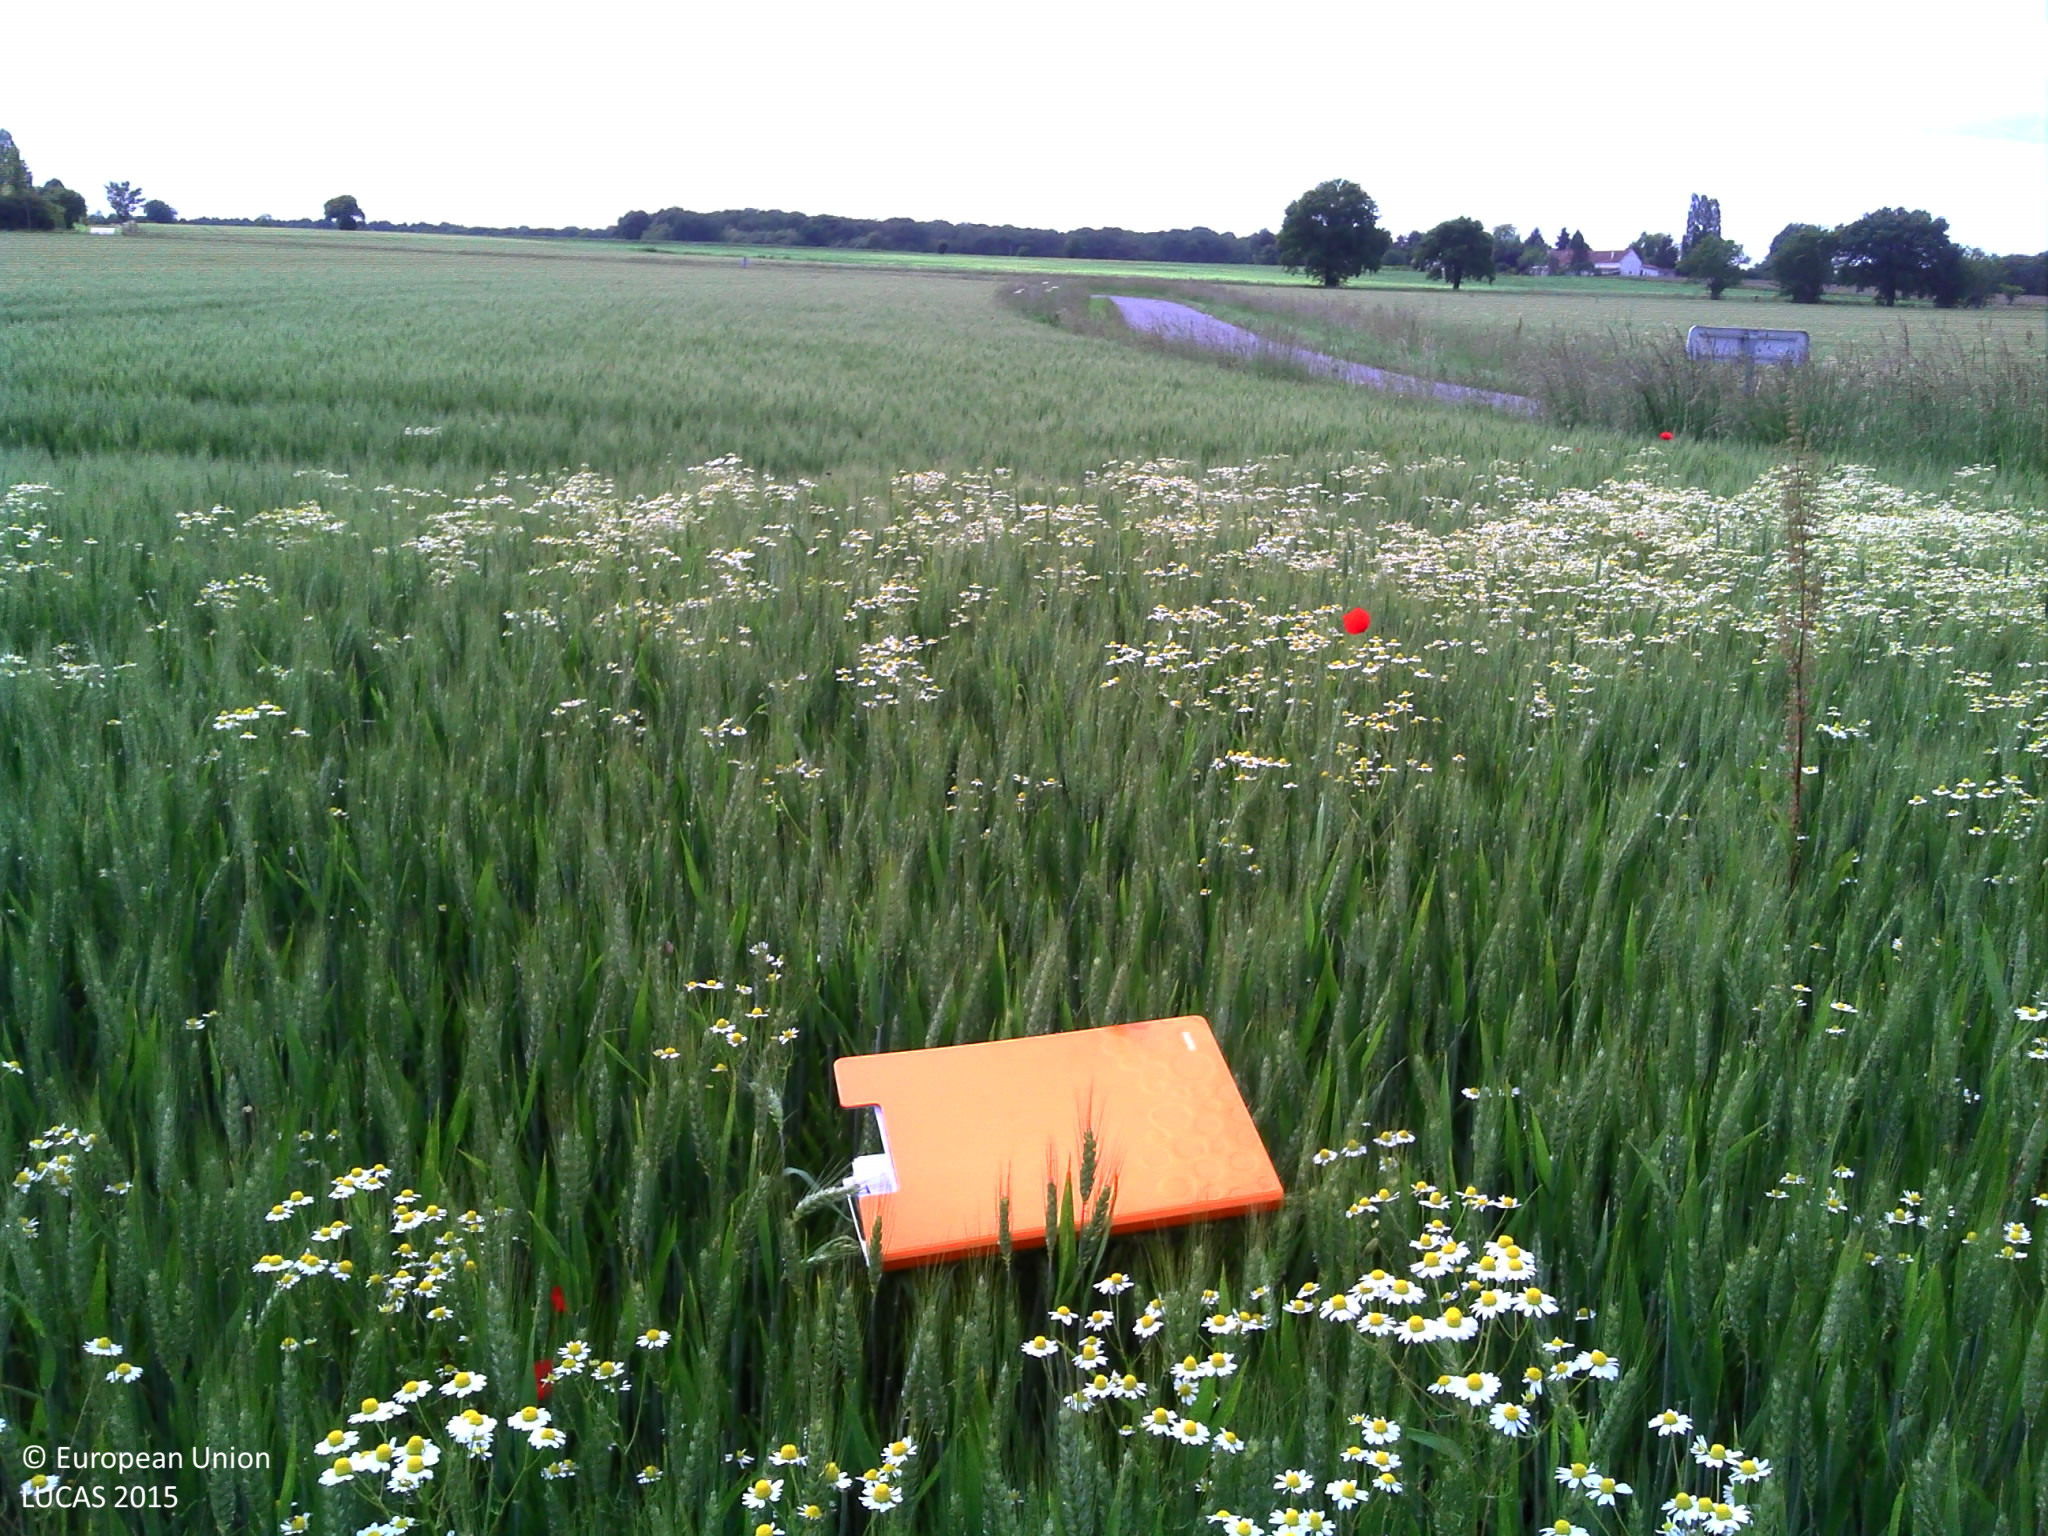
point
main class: Cropland
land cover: Common wheat
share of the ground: > 75 %
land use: Agriculture (excluding fallow land and kitchen gardens)
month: May
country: FR
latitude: 47.2554
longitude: 2.9251
